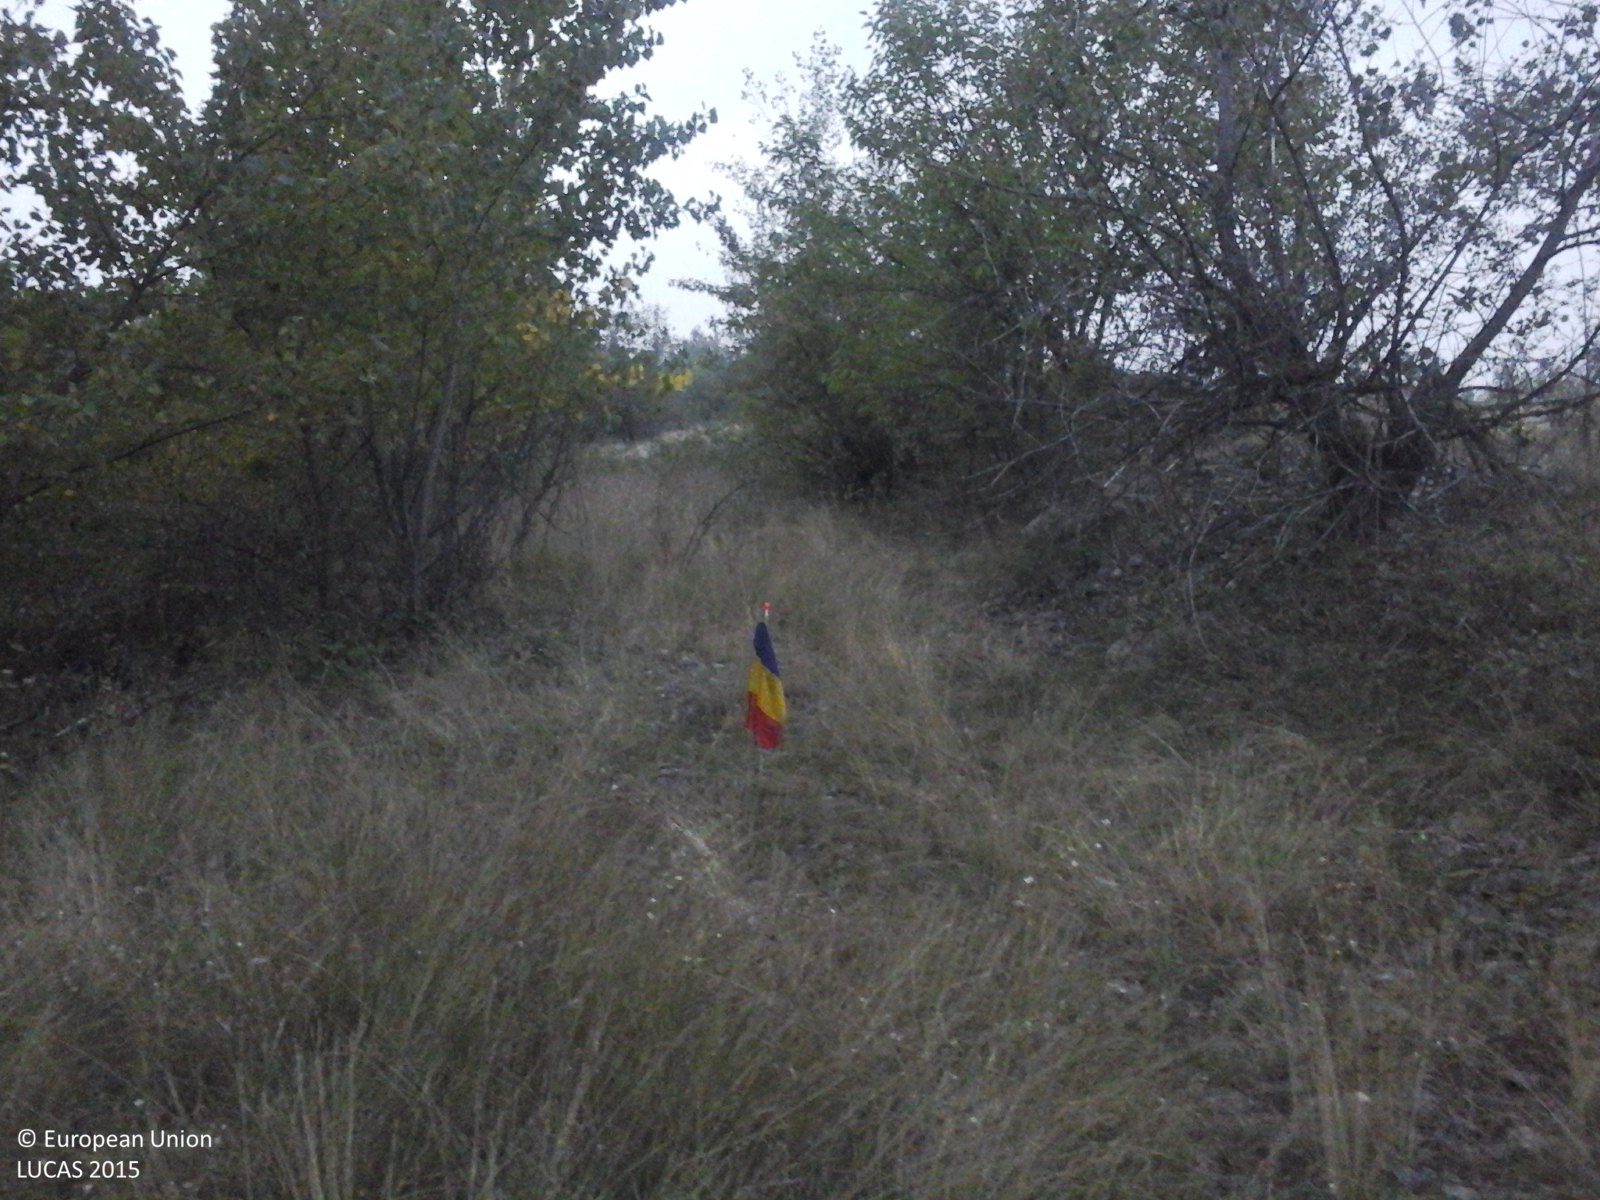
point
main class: Grassland
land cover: Spontaneously vegetated surfaces
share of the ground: > 75 %
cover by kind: herbaceous plants 60 %, consolidated bare surface 40 %
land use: Semi-natural and natural areas not in use
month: September
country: RO
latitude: 45.1422
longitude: 23.3713
